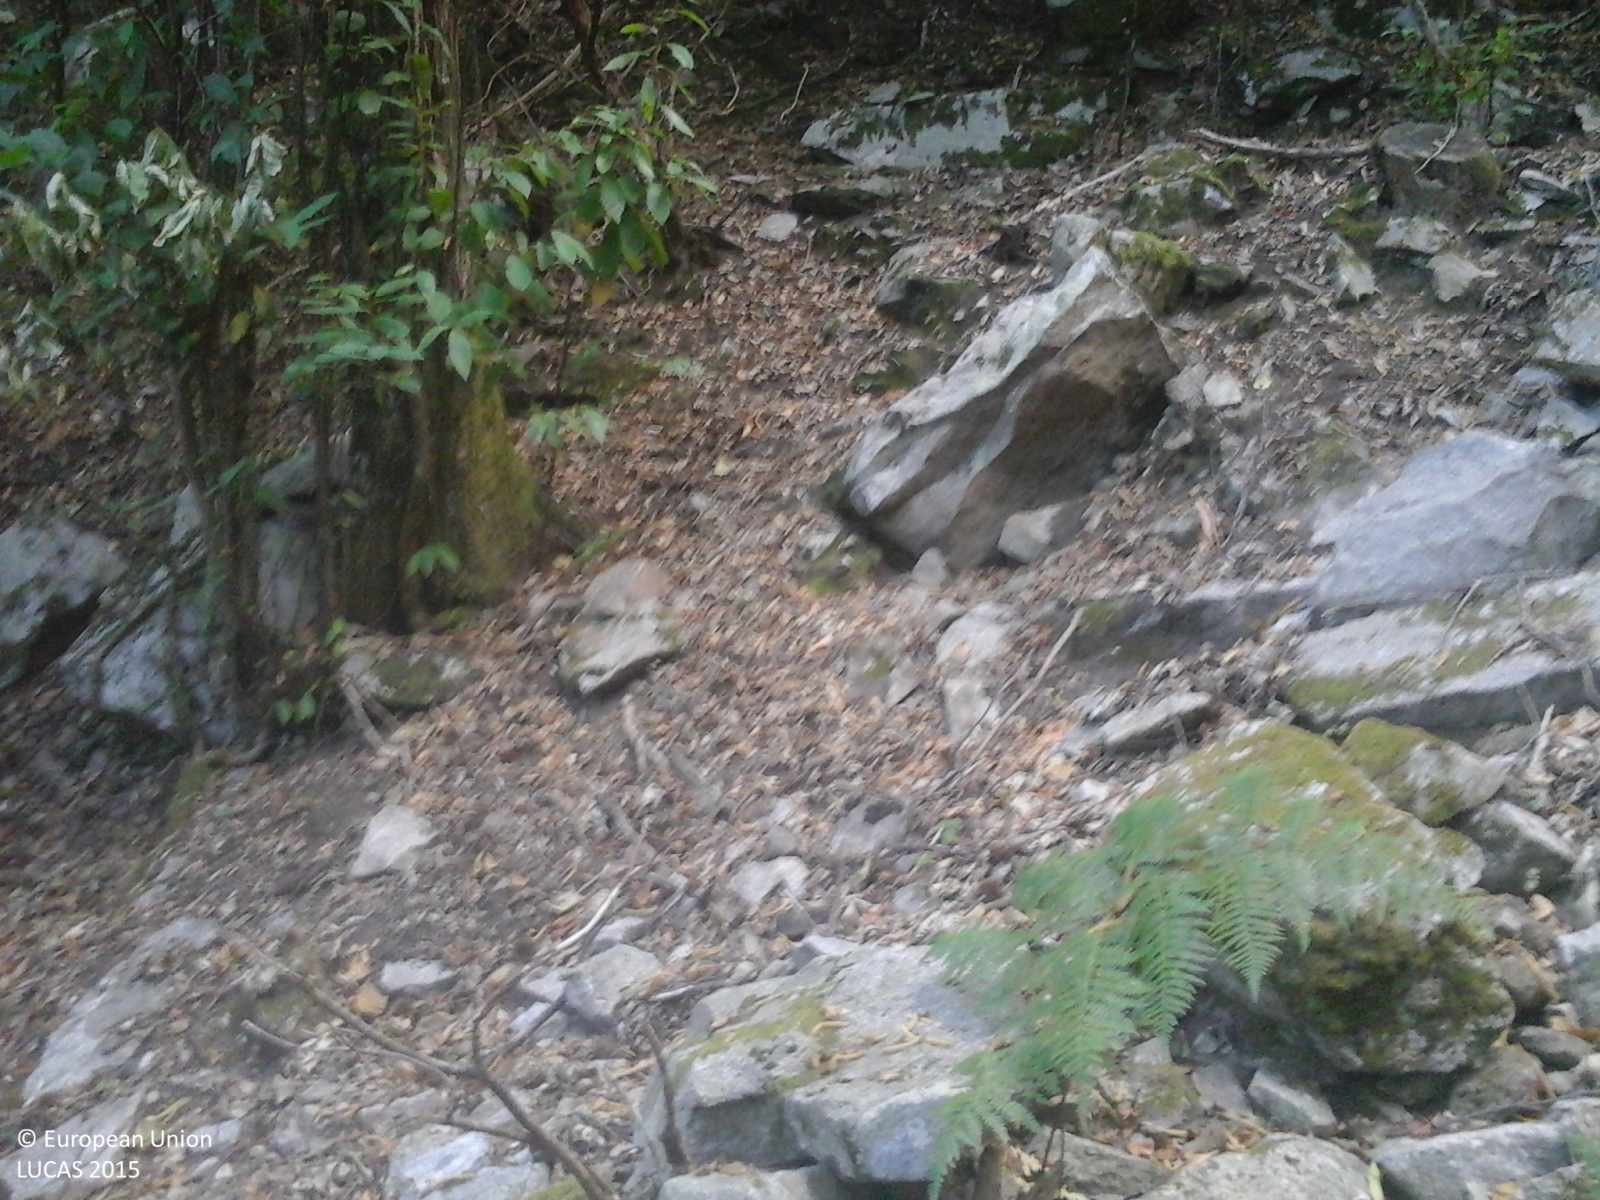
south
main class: Woodland
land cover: Broadleaved woodland
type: thermophilous deciduous forest
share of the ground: > 75 %
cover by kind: broadleaved forest trees 100 %
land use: Forestry
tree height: > 5 m
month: July
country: IT
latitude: 42.7803
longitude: 10.1827
